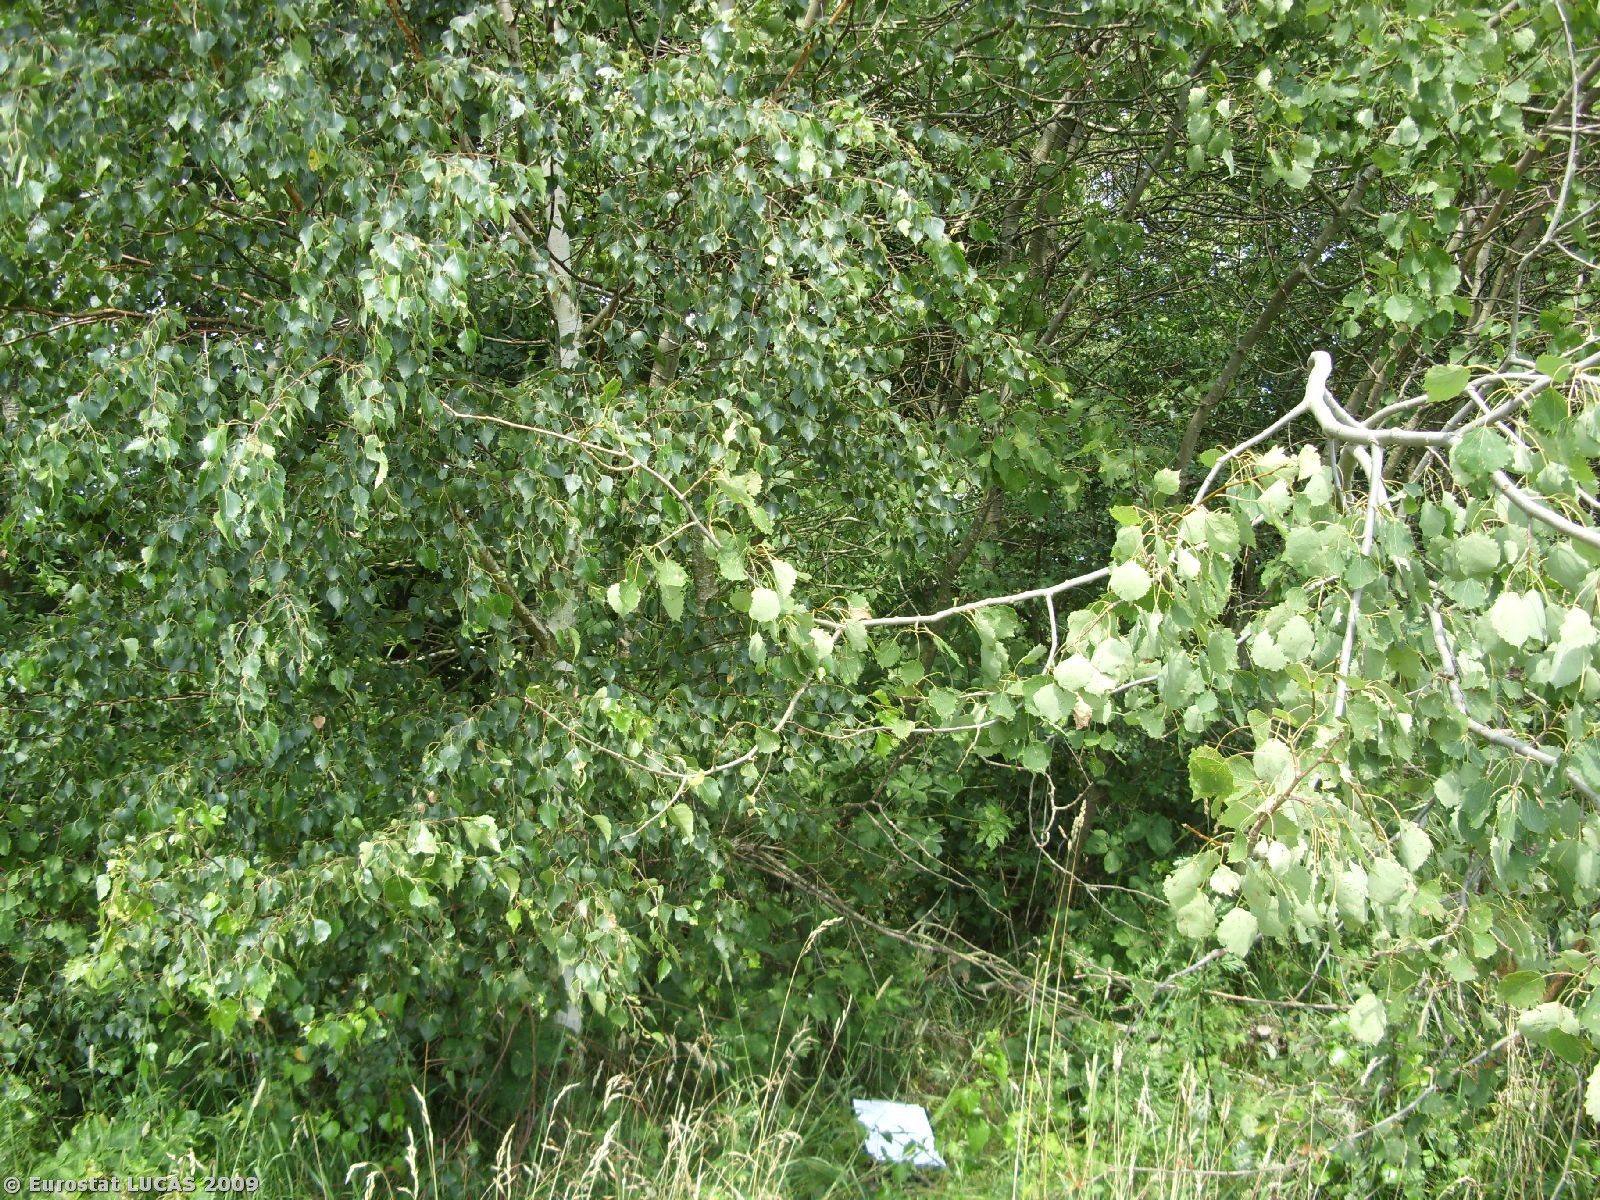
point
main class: Woodland
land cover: Broadleaved woodland
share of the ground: > 75 %
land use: Unused
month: July
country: PL
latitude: 53.9973
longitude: 15.5099
